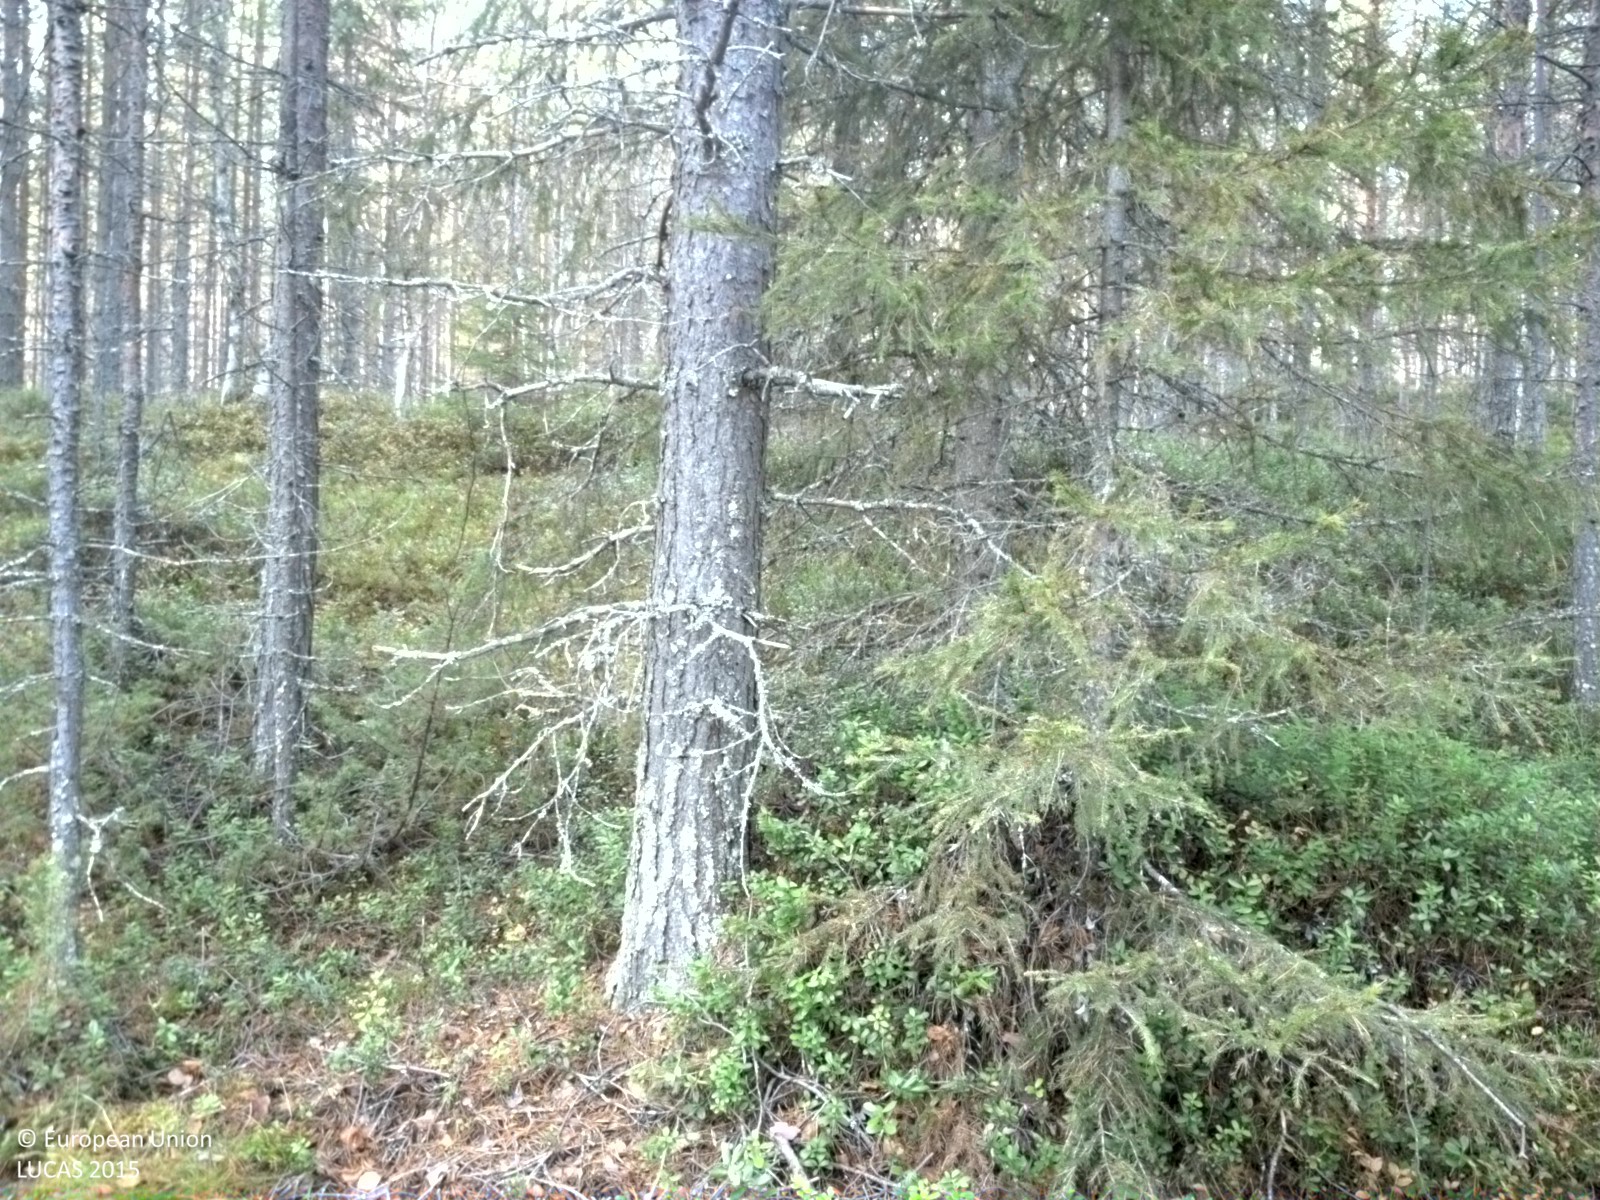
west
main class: Woodland
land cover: Pine dominated coniferous woodland
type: boreal forest
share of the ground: 25 - 50 %
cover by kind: shrubs 60 %, coniferous forest trees 35 %, lichens and mosses 5 %
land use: Forestry
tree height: > 5 m
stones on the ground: 25 - 50 %
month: October
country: SE
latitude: 65.9418
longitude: 20.8904
